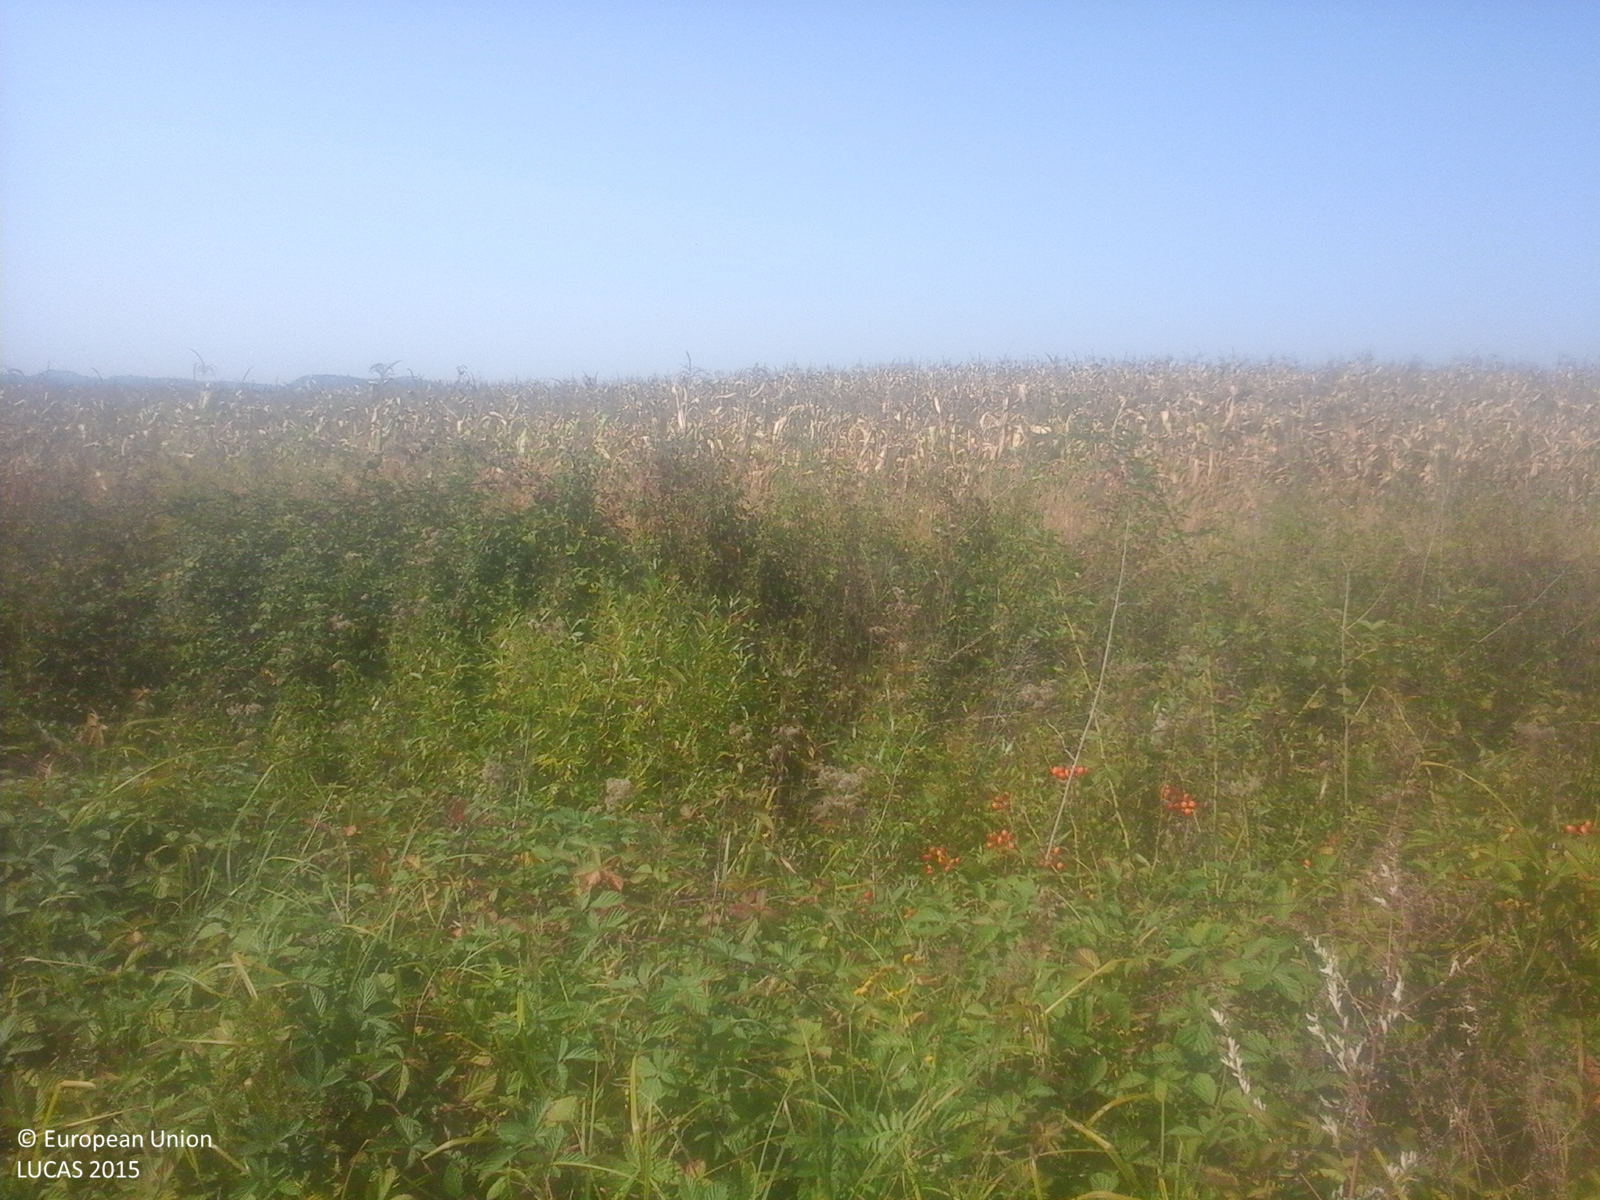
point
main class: Cropland
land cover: Maize
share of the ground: > 75 %
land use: Agriculture (excluding fallow land and kitchen gardens)
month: September
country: RO
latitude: 46.6733
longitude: 22.3243
